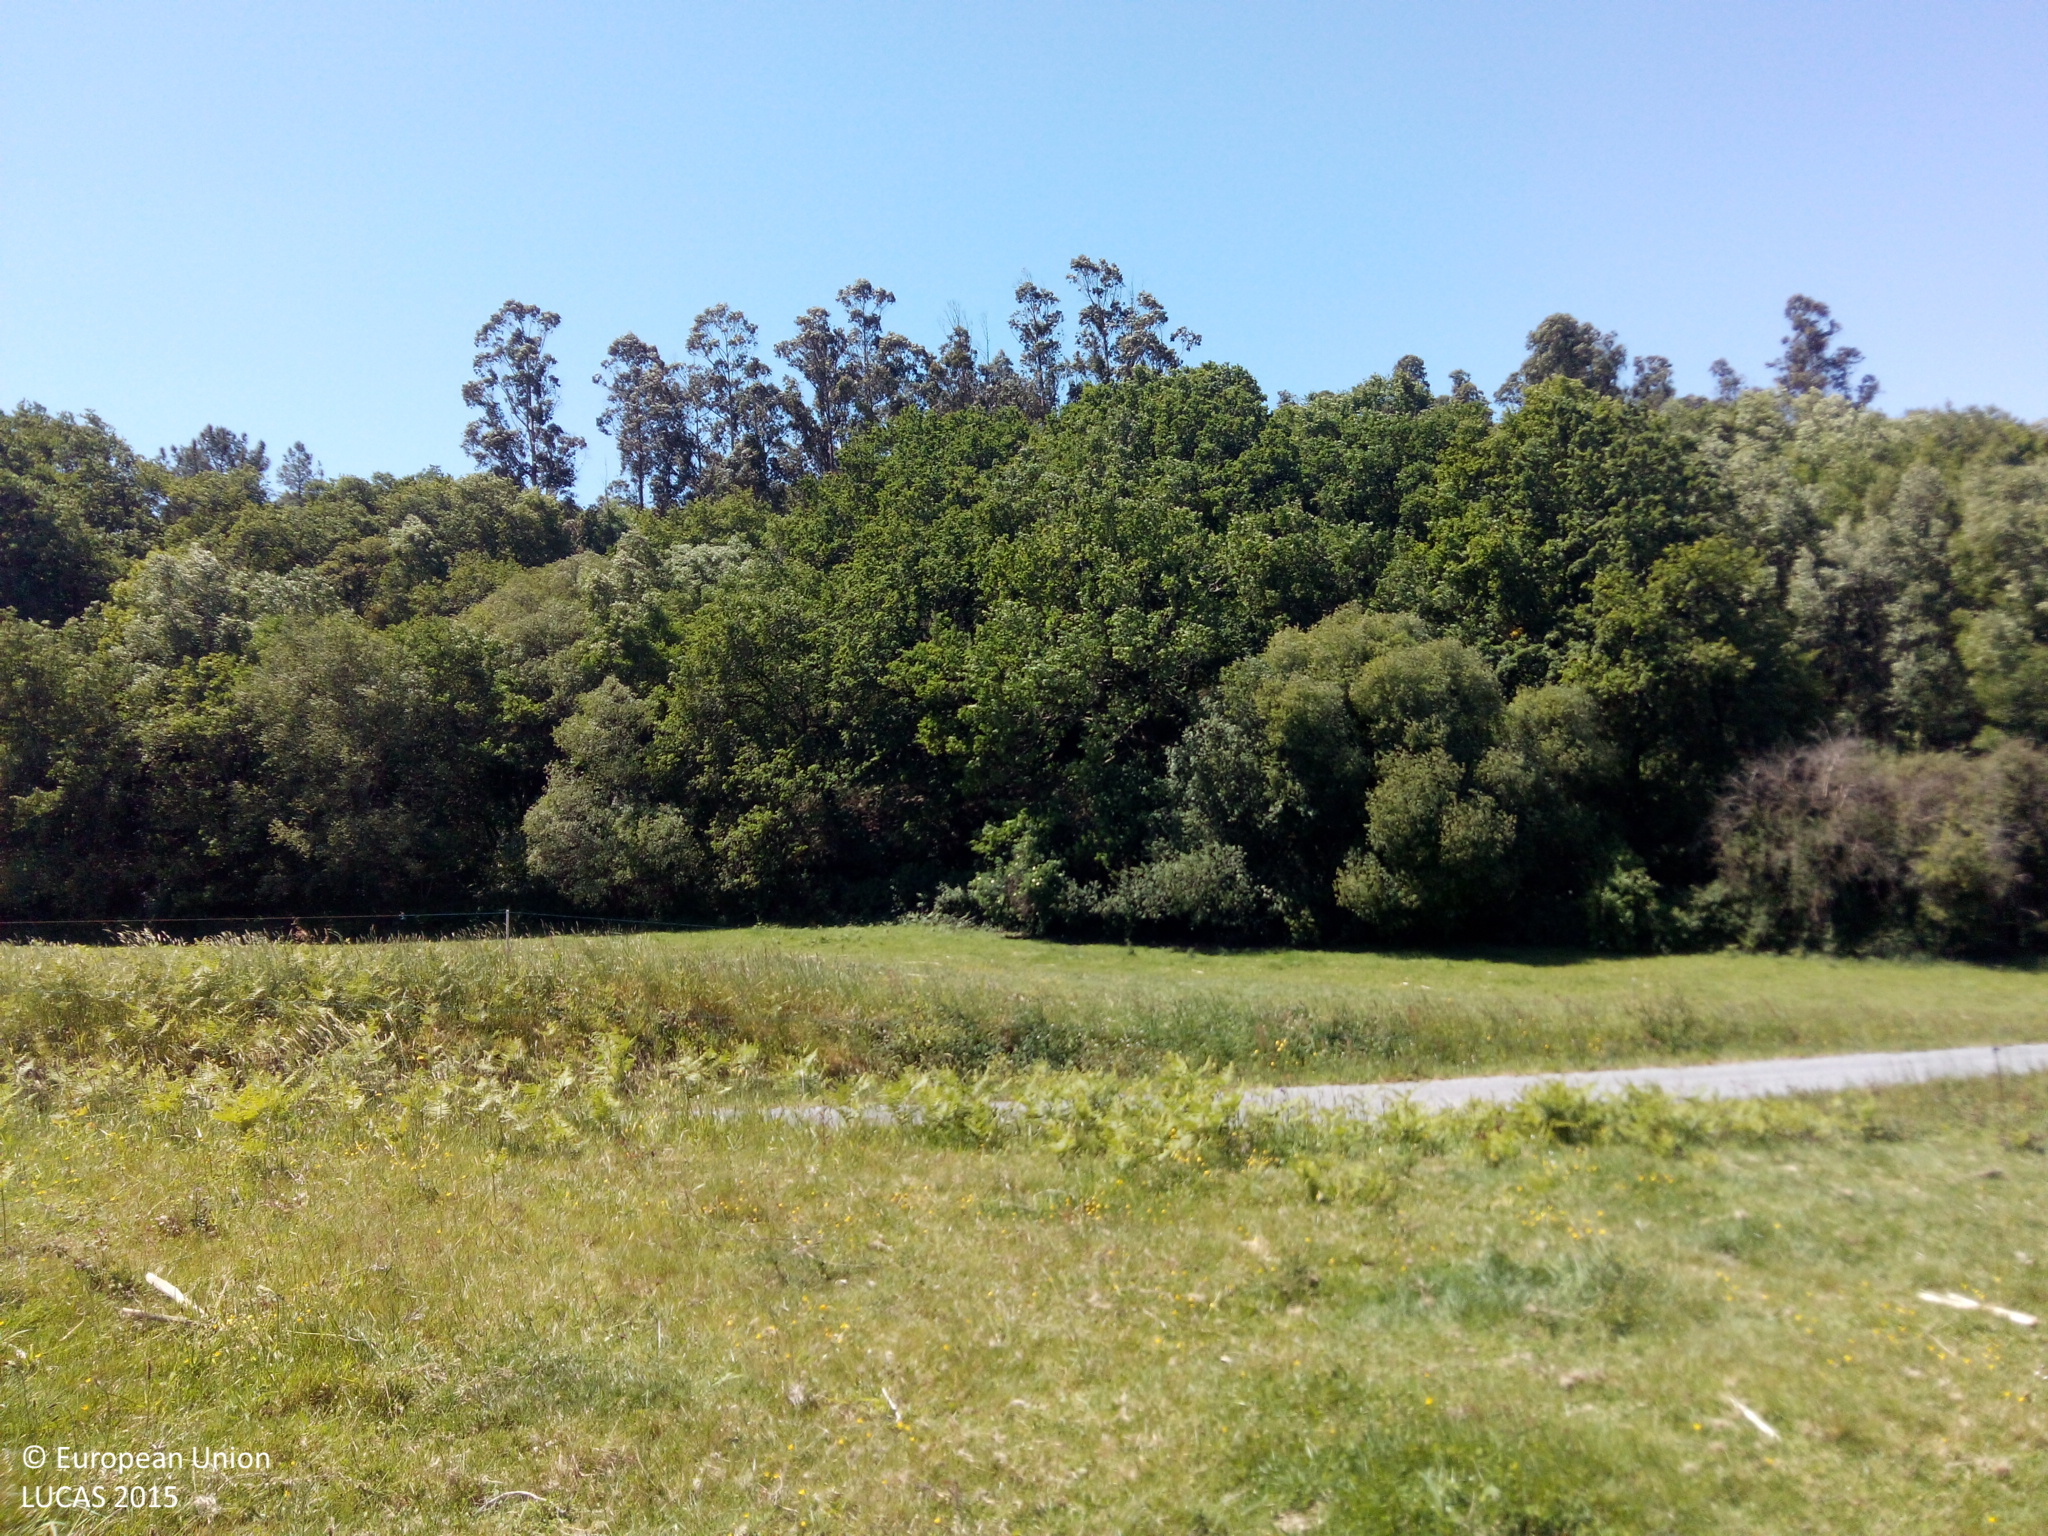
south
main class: Grassland
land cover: Grassland without tree/shrub cover
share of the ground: > 75 %
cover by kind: herbaceous plants 100 %
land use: Agriculture (excluding fallow land and kitchen gardens)
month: May
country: ES
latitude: 42.6451
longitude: -8.4298
